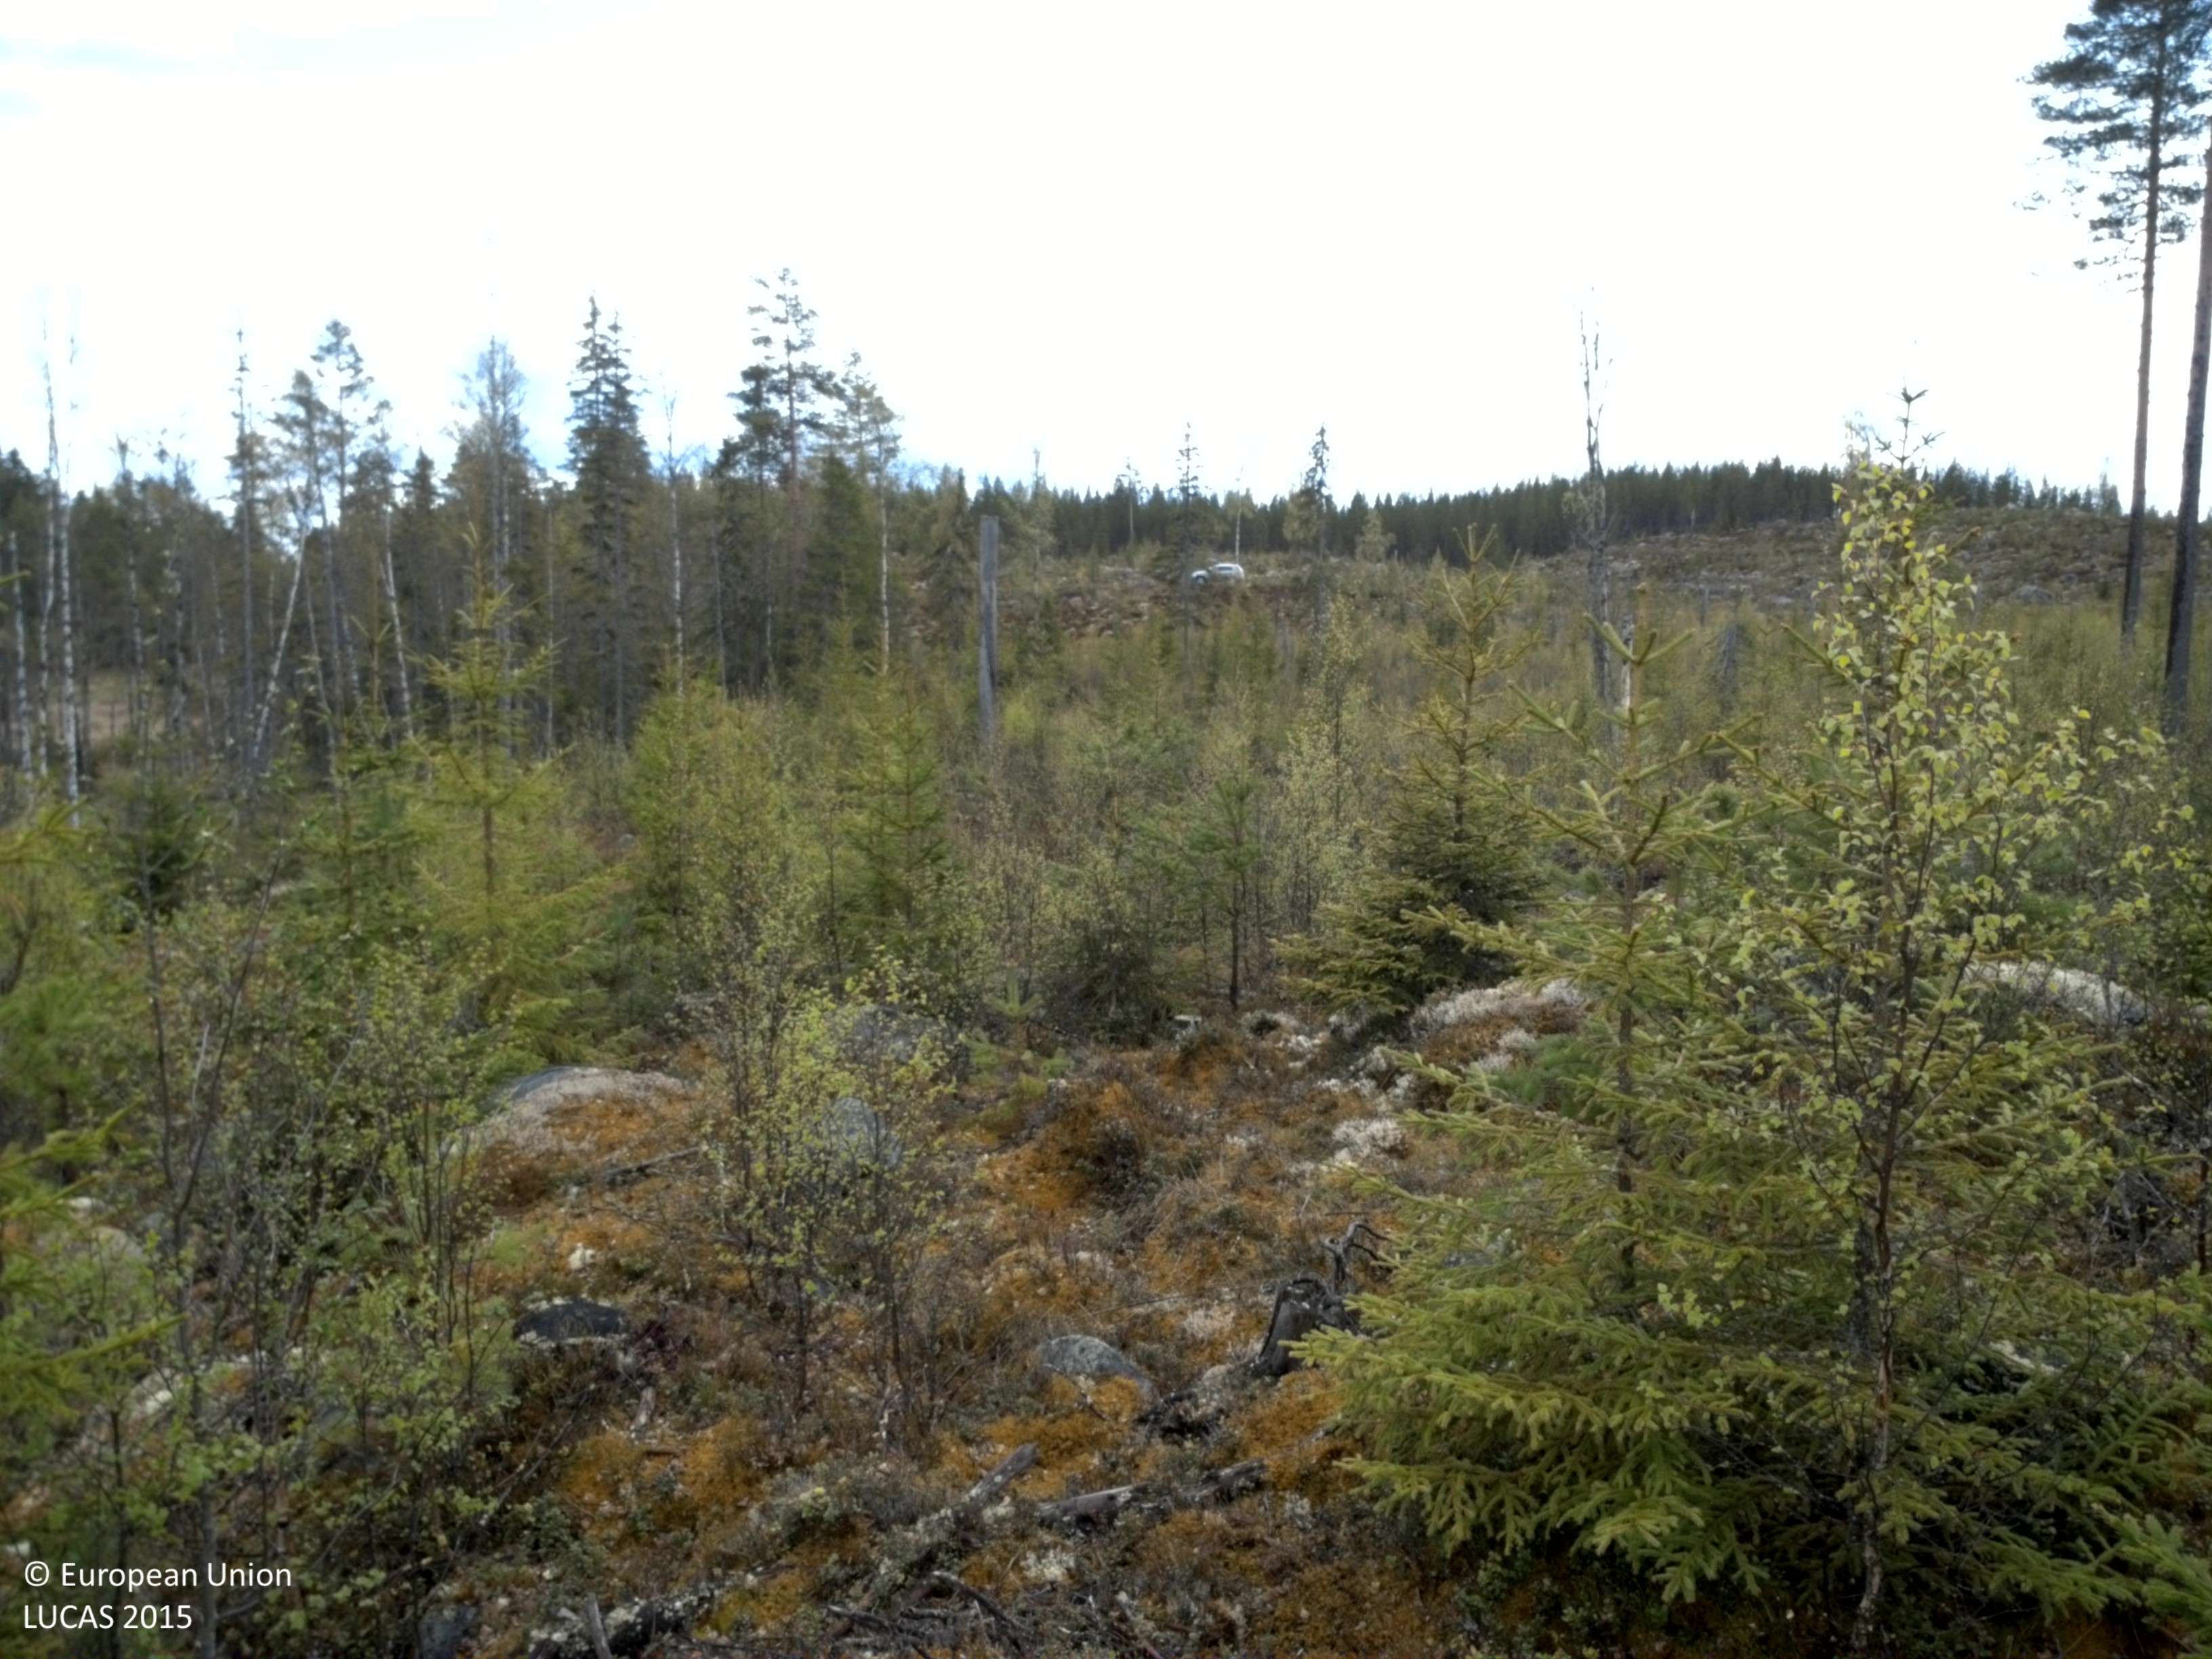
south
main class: Woodland
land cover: Spruce dominated mixed woodland
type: boreal forest
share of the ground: > 75 %
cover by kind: coniferous forest trees 60 %, broadleaved forest trees 25 %, herbaceous plants 10 %, lichens and mosses 5 %
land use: Forestry
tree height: < 5 m
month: May
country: SE
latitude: 61.1096
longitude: 15.3108
